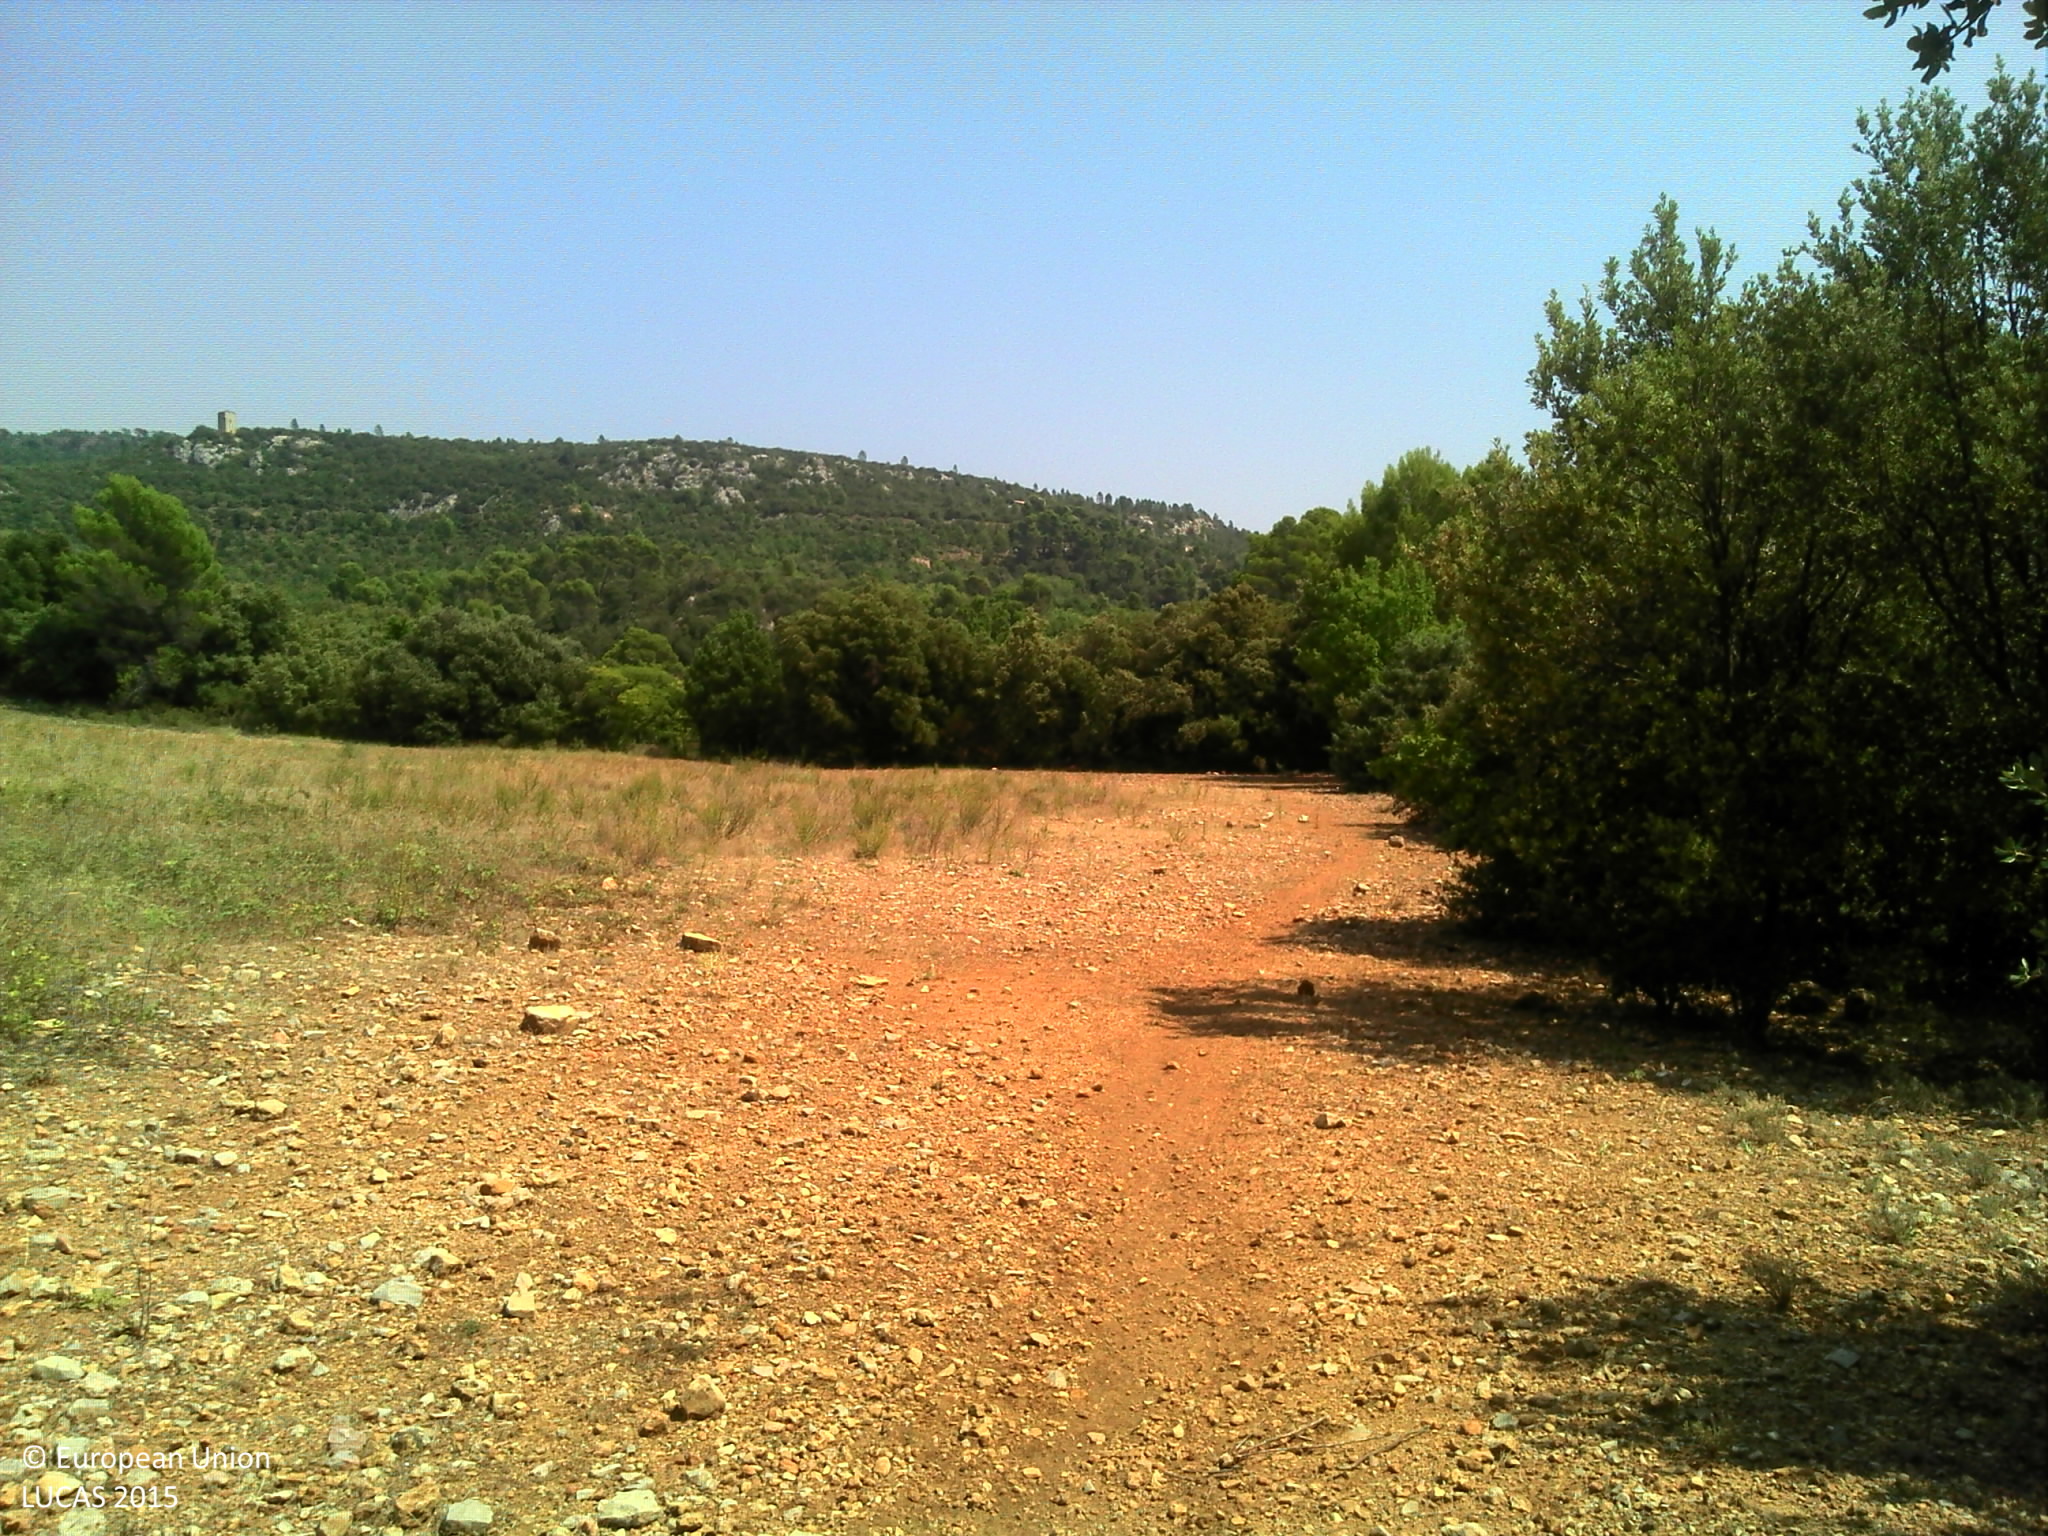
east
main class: Grassland
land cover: Spontaneously vegetated surfaces
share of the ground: > 75 %
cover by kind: herbaceous plants 75 %, unconsolidated bare surface 20 %, shrubs 5 %
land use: Semi-natural and natural areas not in use
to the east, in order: Spontaneously vegetated surfaces; Rock outcrops; Broadleaved woodland; Shrubland without tree cover; Broadleaved woodland; Pine dominated mixed woodland; Electric lines; Pine dominated mixed woodland
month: August
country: FR
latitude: 43.5977
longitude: 6.2800
